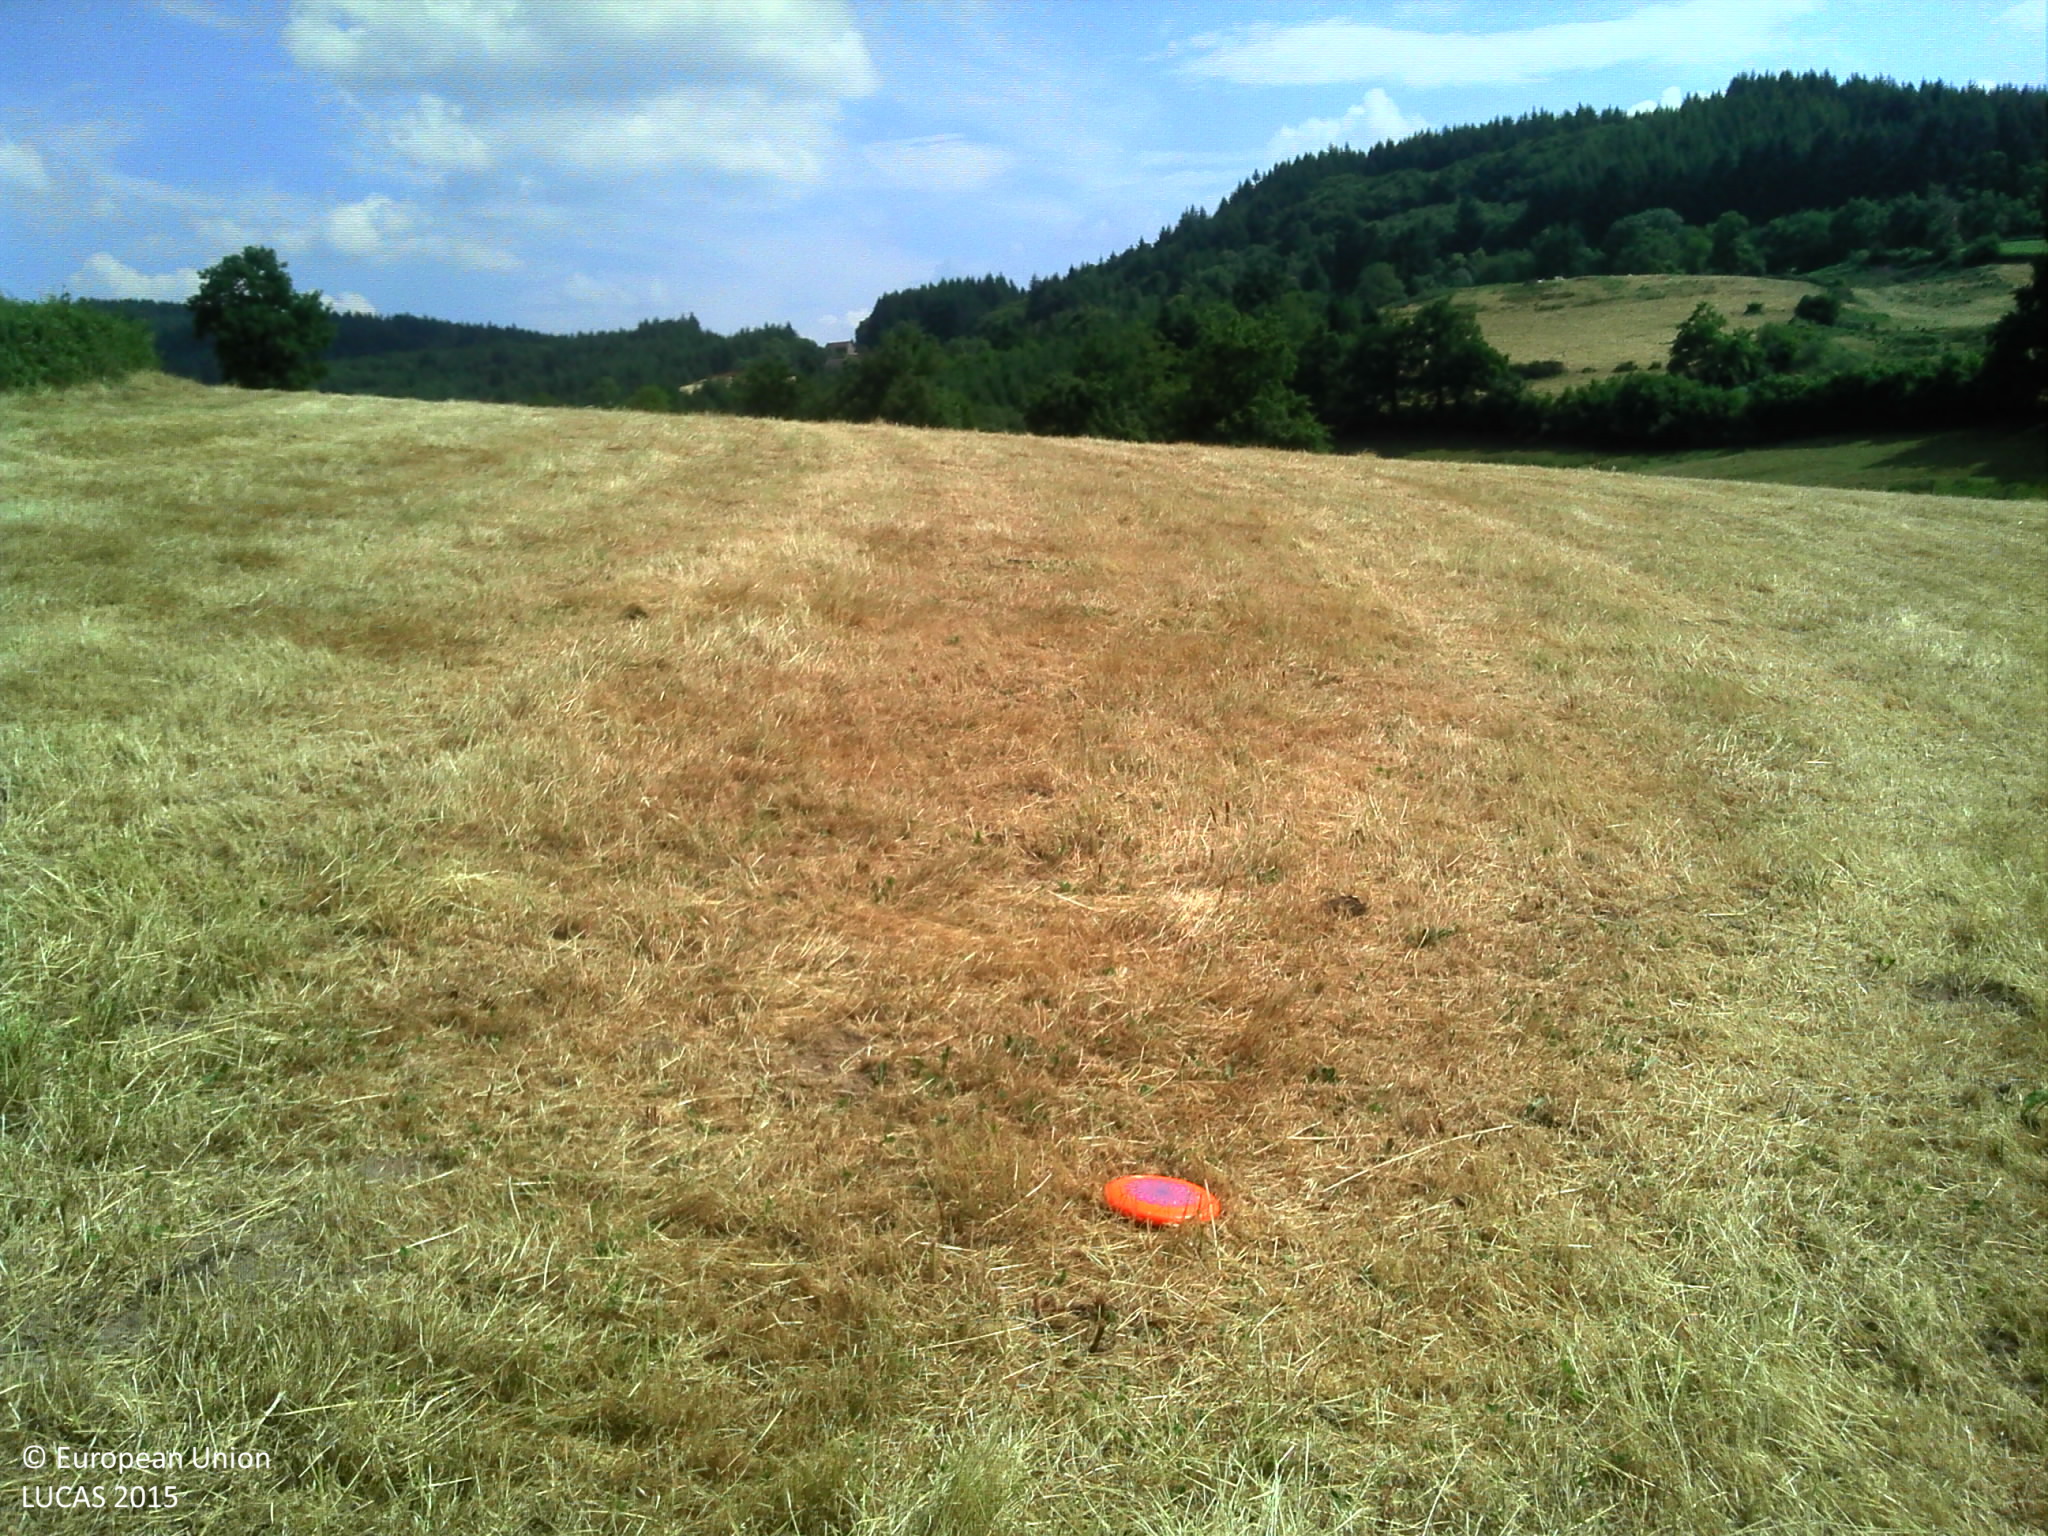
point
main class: Grassland
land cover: Grassland without tree/shrub cover
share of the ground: > 75 %
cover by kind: herbaceous plants 100 %
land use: Agriculture (excluding fallow land and kitchen gardens)
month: June
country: FR
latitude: 46.3670
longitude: 4.3990
